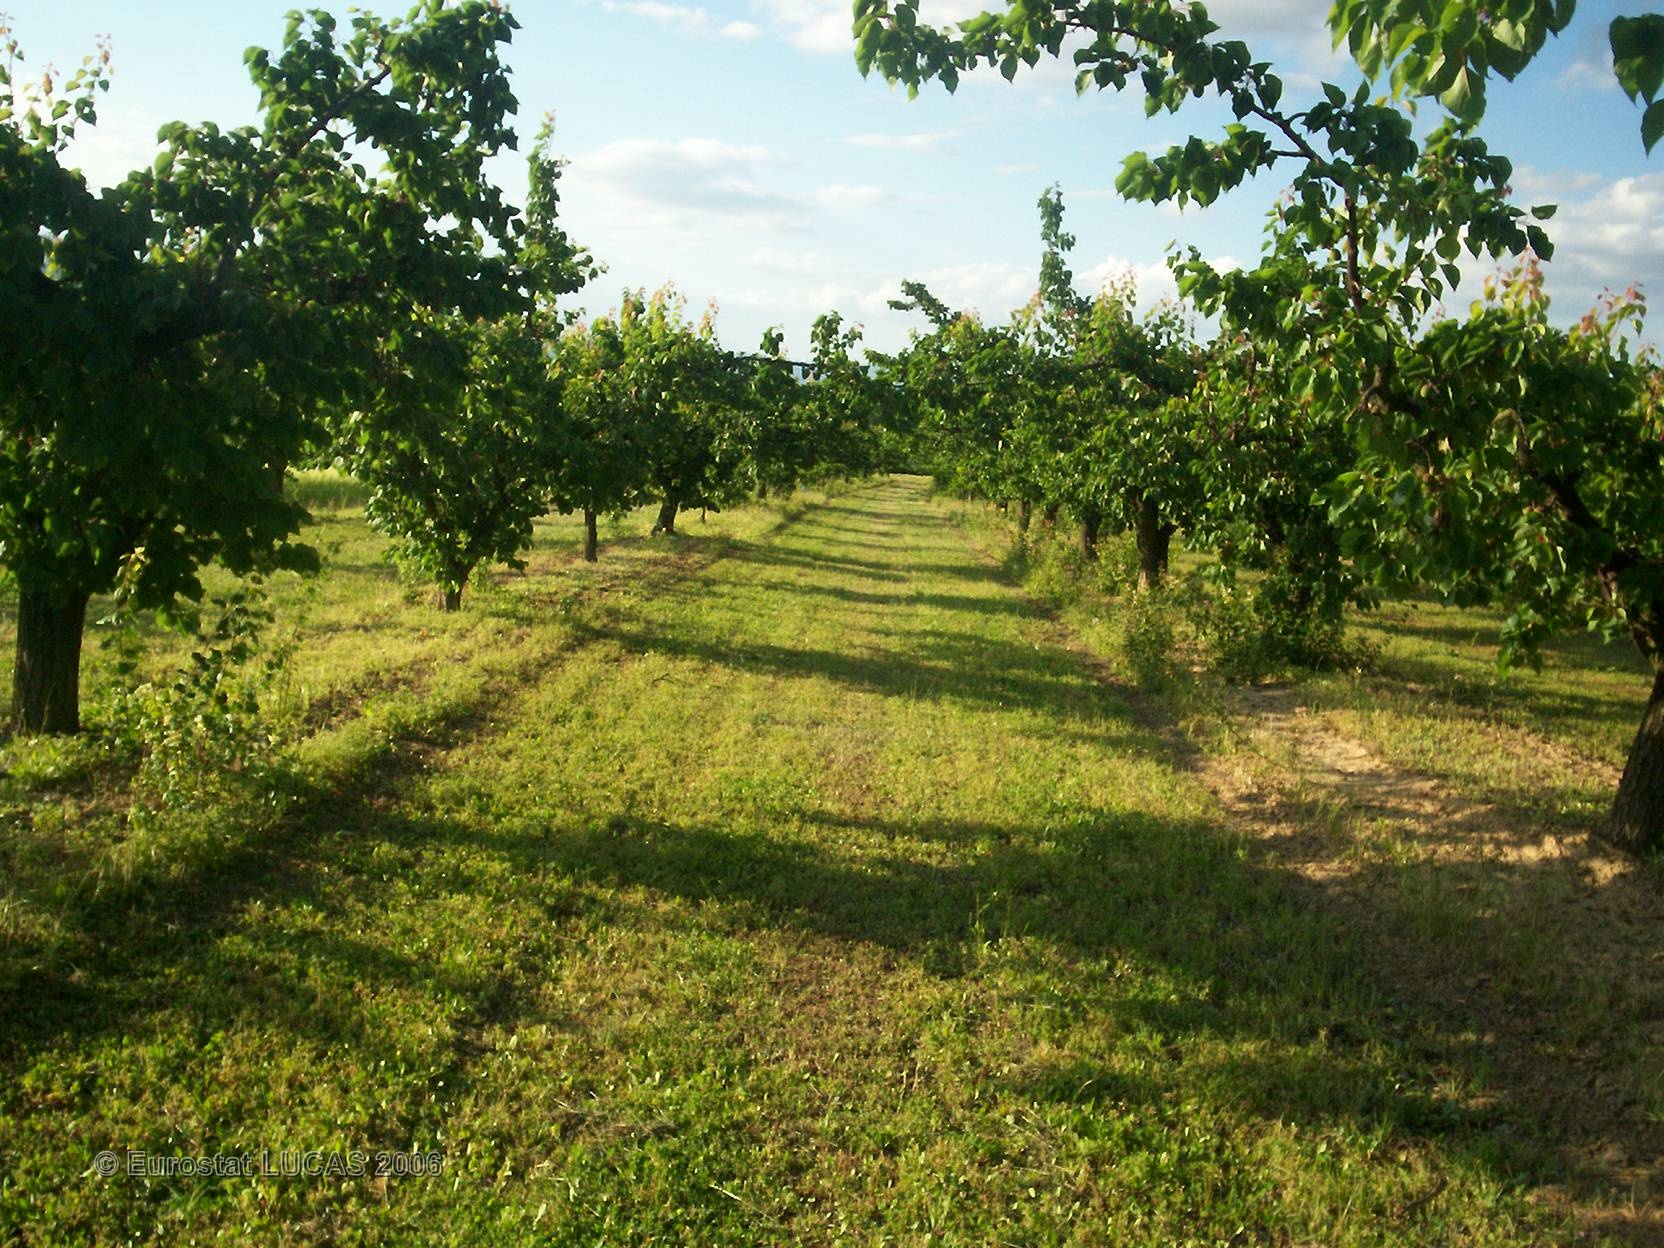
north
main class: Cropland
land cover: Other fruit trees and berries
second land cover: Grassland with sparse tree/shrub cover
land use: Agriculture (excluding fallow land and kitchen gardens)
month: May
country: FR
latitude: 45.3022
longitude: 4.7631
